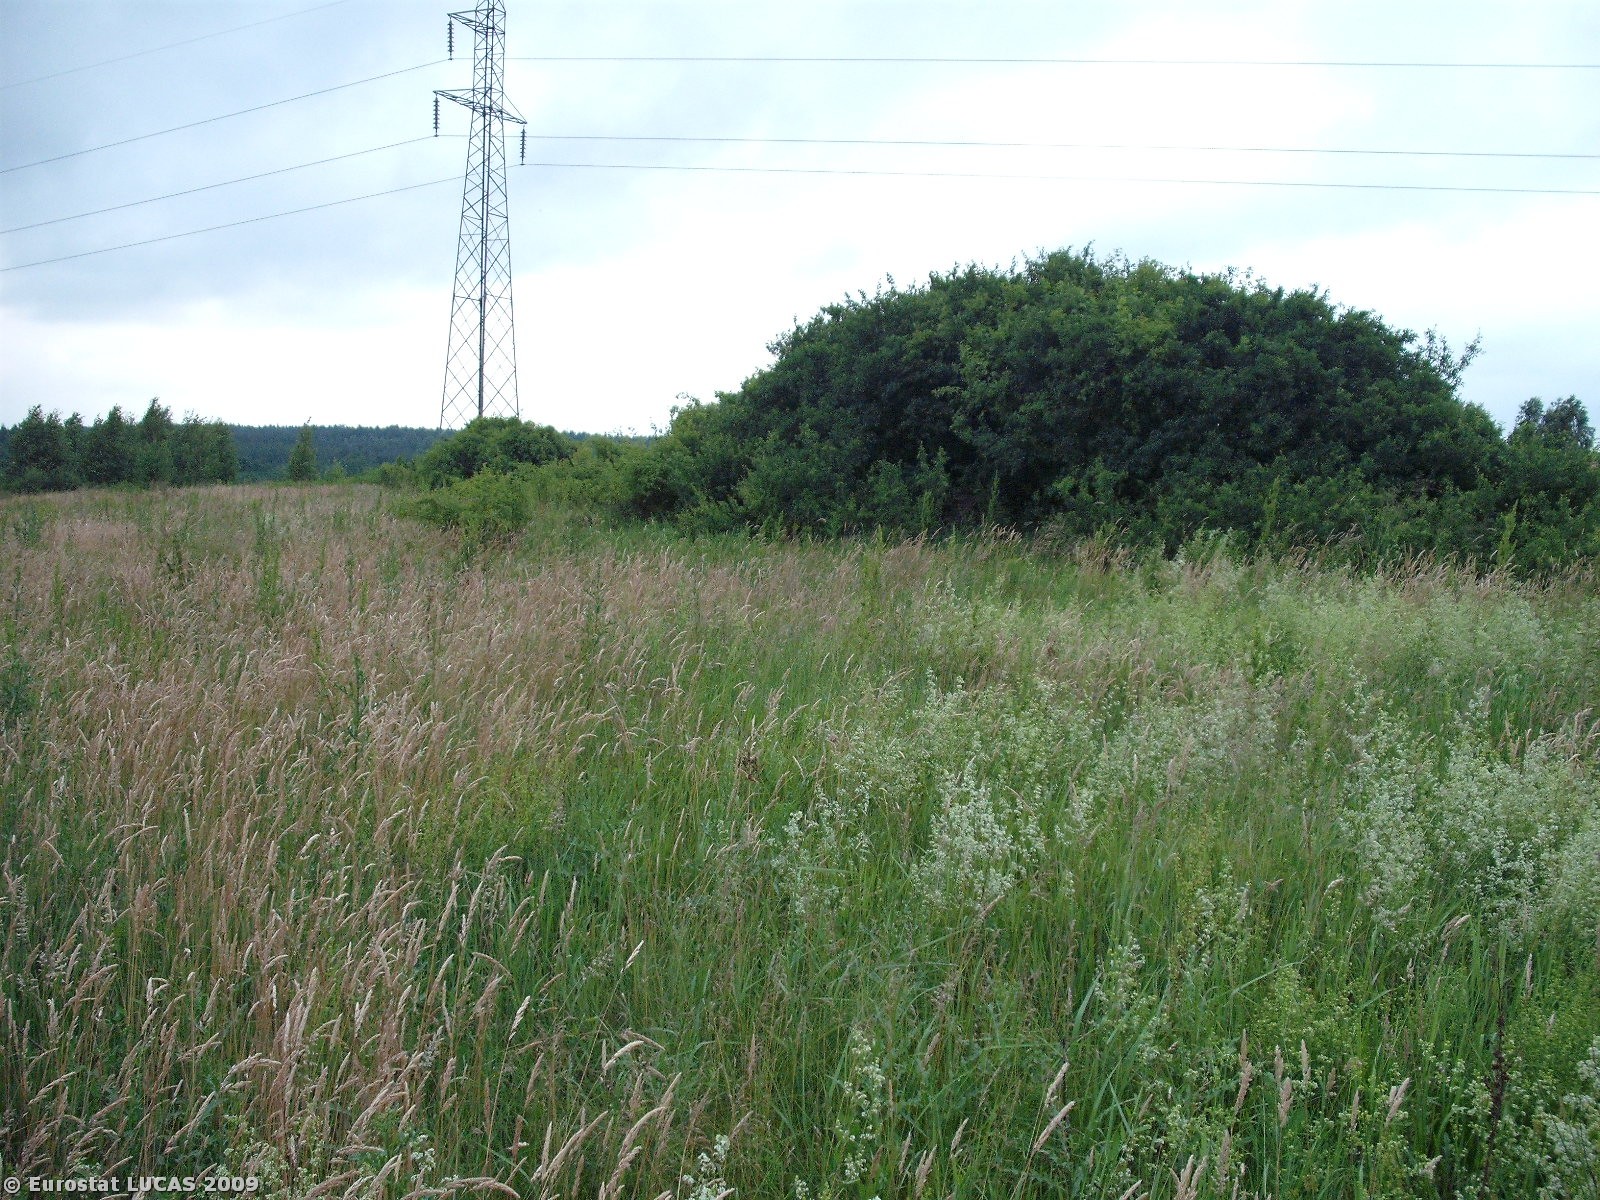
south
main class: Grassland
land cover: Spontaneously vegetated surfaces
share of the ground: > 75 %
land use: Fallow land
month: June
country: PL
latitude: 51.3986
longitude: 20.5460
